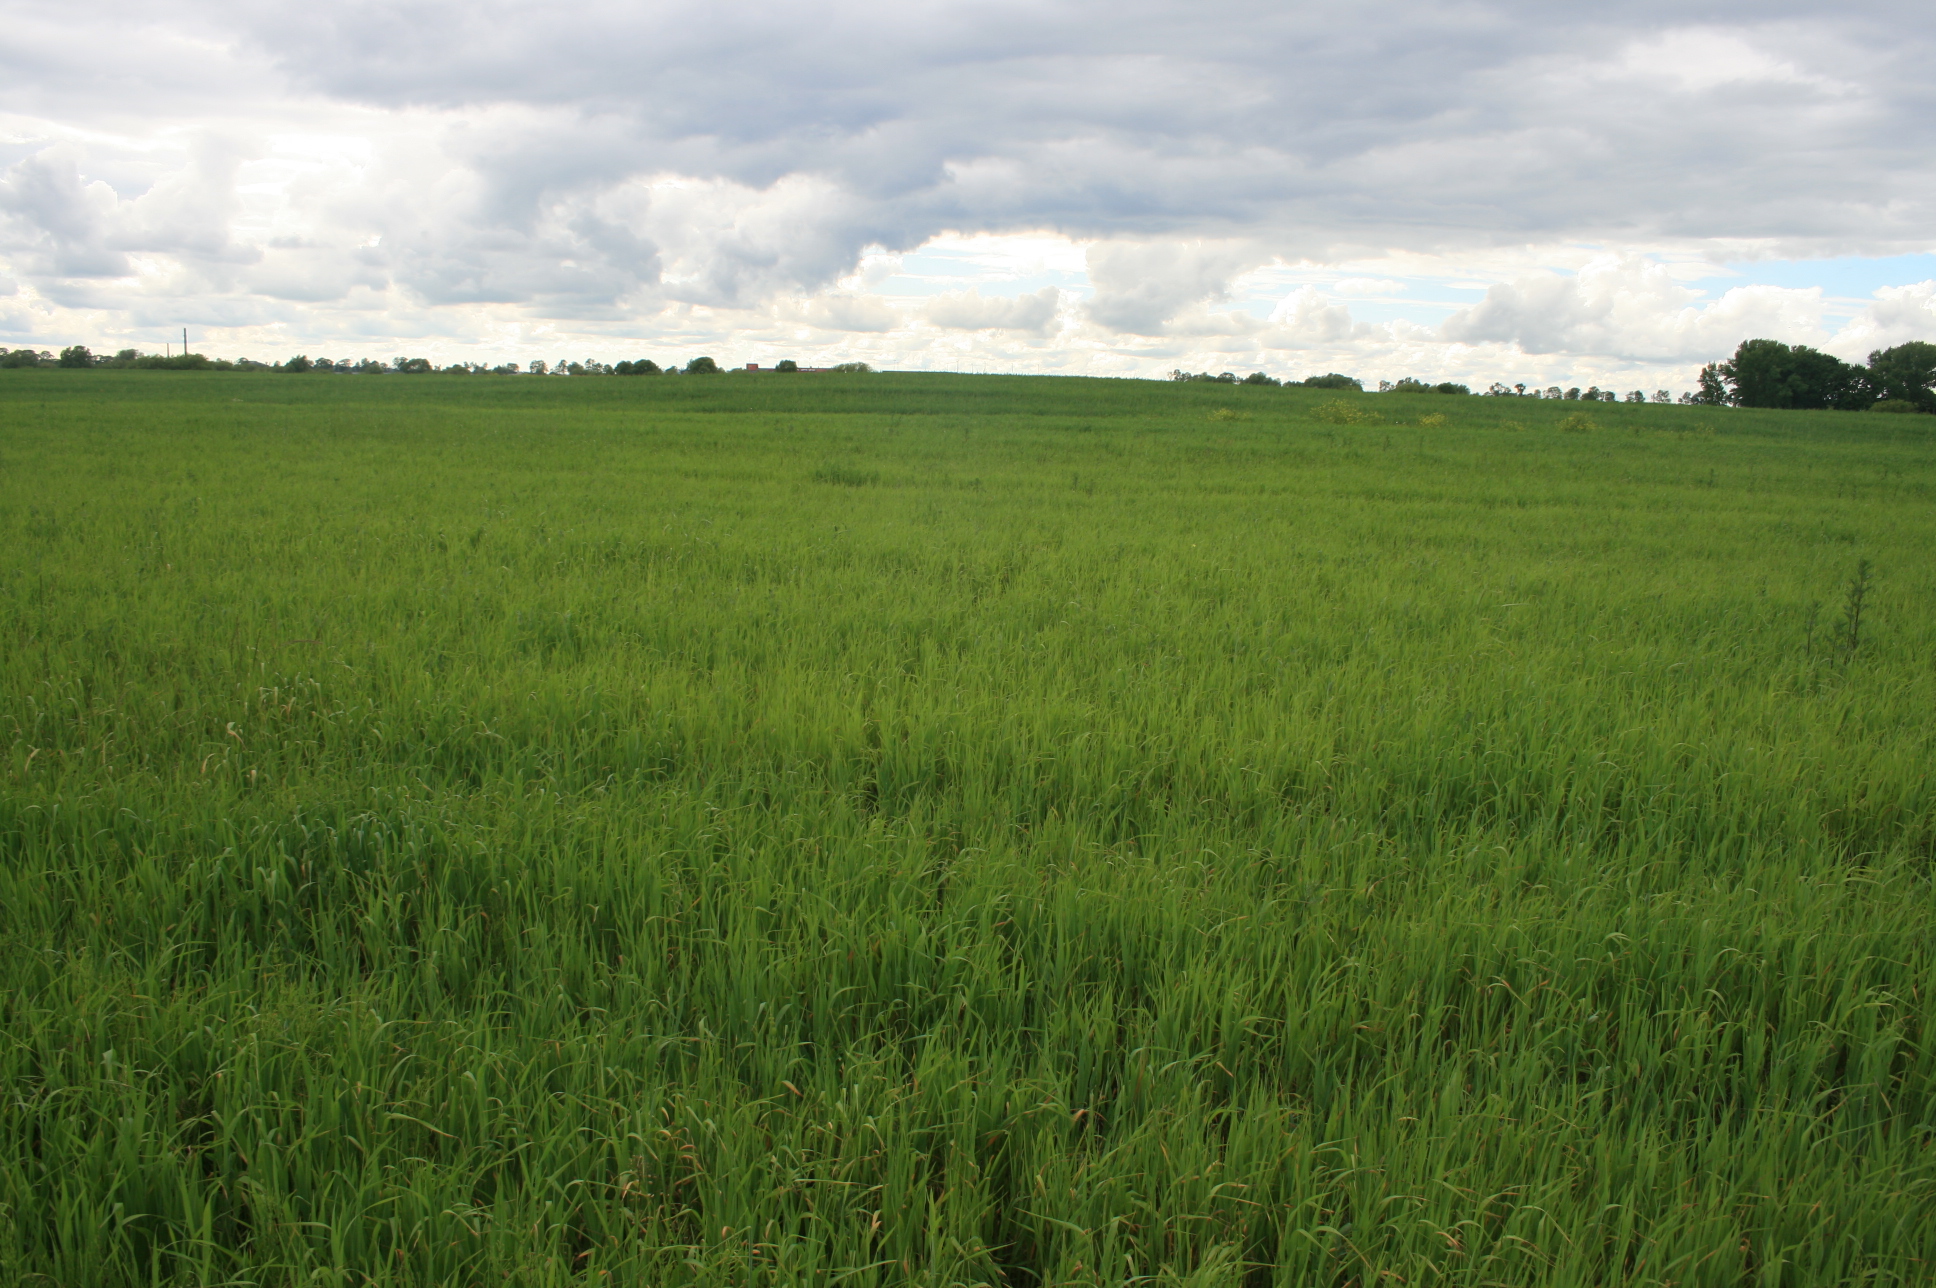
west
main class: Cropland
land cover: Mixed cereals for fodder
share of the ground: > 75 %
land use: Agriculture (excluding fallow land and kitchen gardens)
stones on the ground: < 10 %
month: June
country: LT
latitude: 55.0994
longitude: 21.9484
